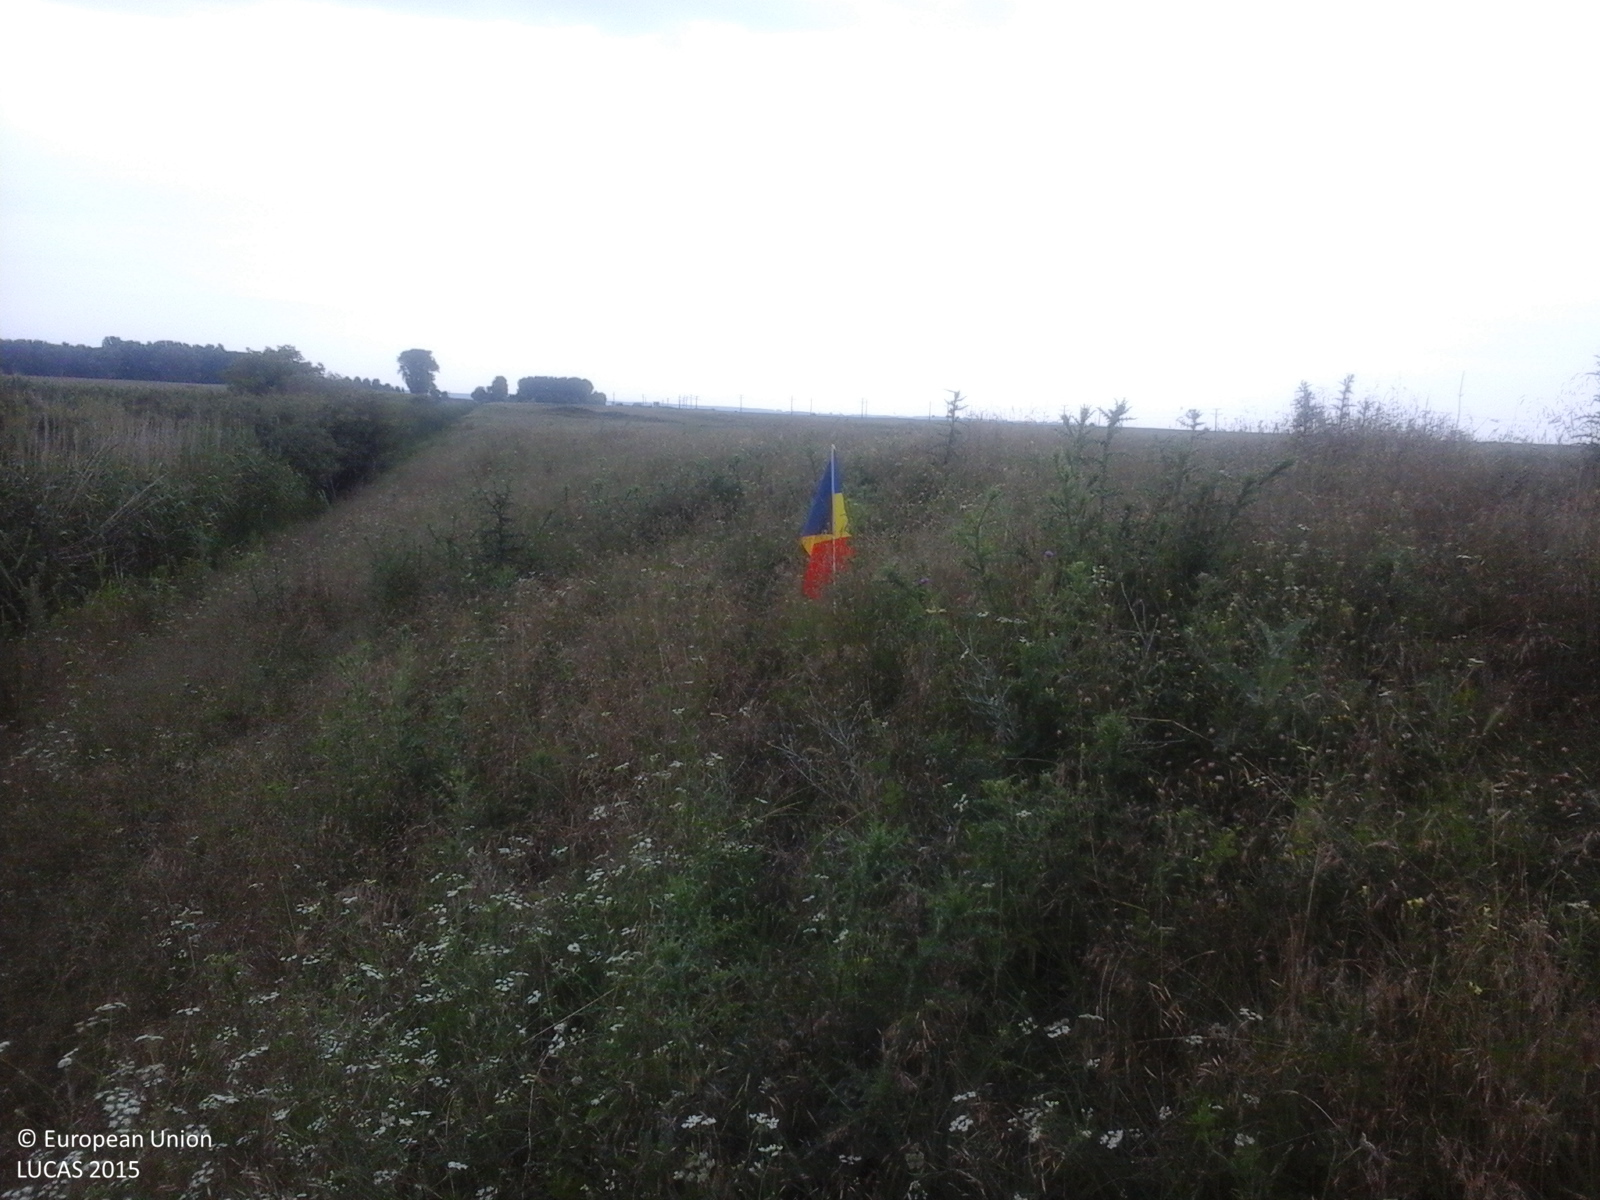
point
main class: Grassland
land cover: Grassland without tree/shrub cover
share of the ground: > 75 %
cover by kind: herbaceous plants 100 %
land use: Agriculture (excluding fallow land and kitchen gardens)
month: June
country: RO
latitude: 44.0639
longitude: 26.1702
